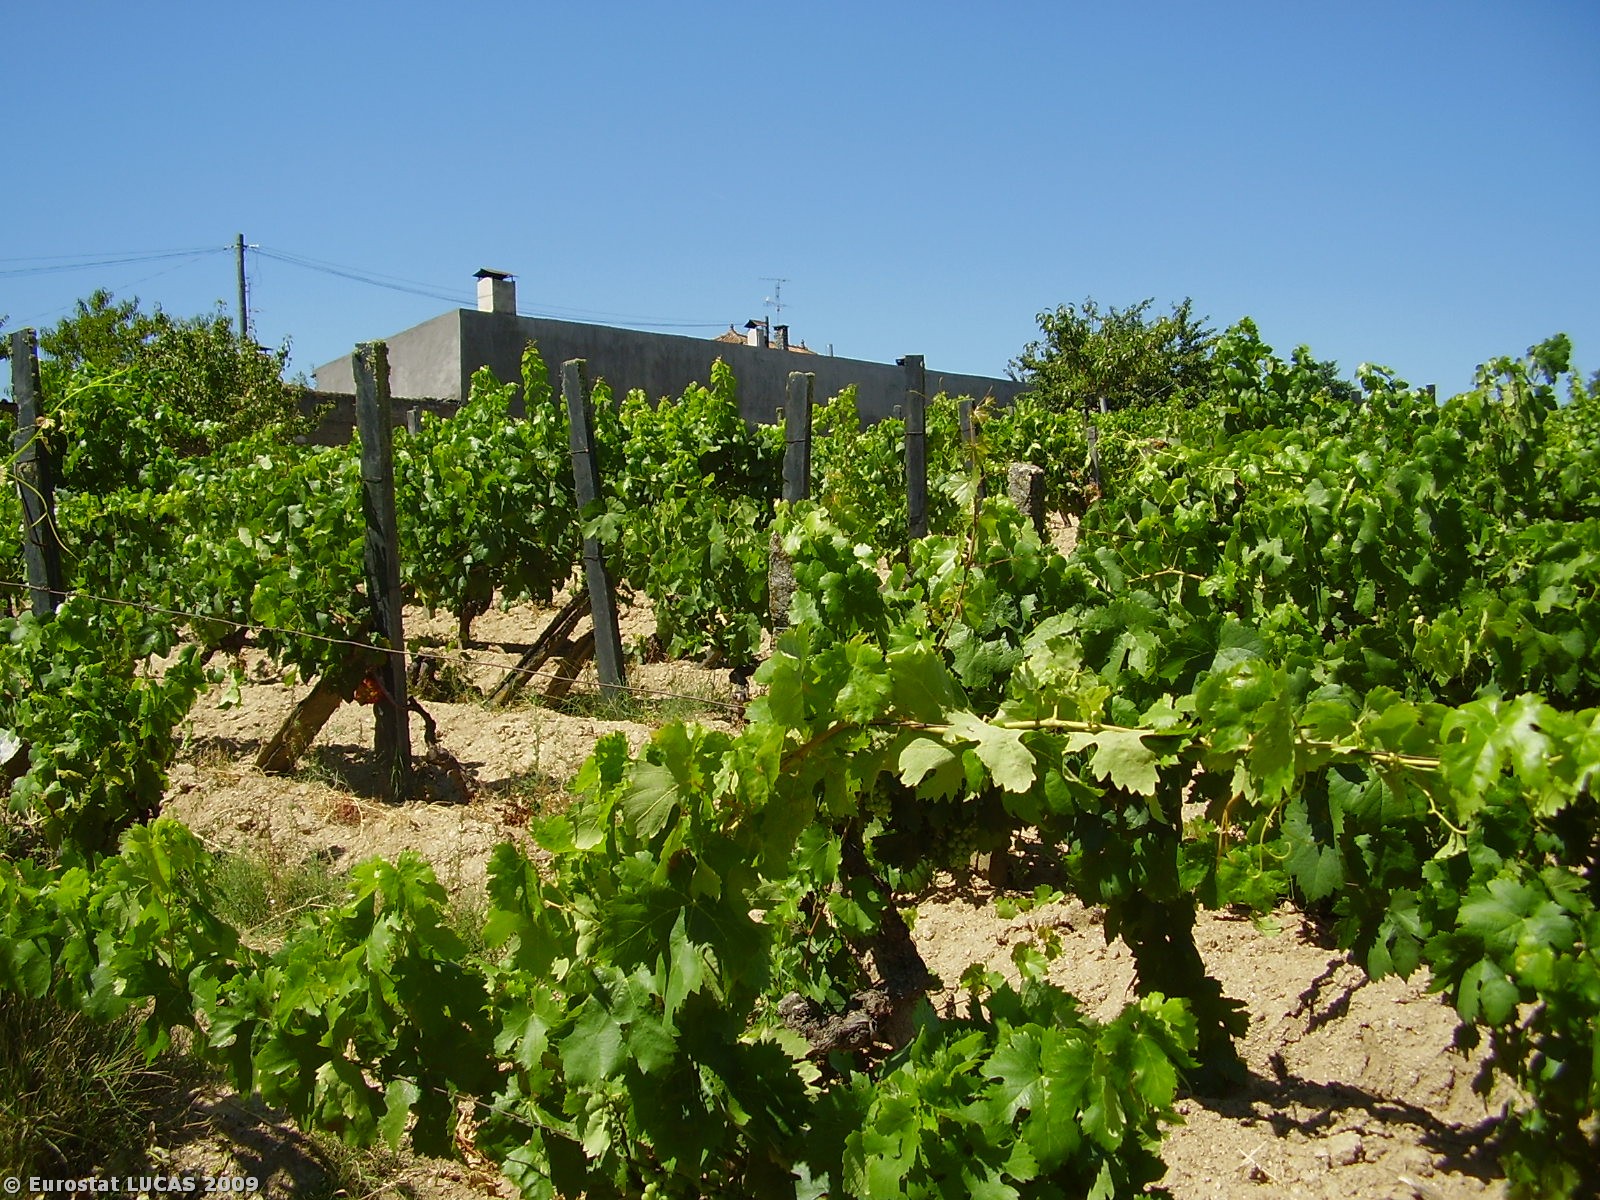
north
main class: Cropland
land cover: Vineyards
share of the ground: 50 - 75 %
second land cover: Bare land
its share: 10 - 25 %
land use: Agriculture (excluding fallow land and kitchen gardens)
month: July
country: PT
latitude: 41.7939
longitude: -7.4226
